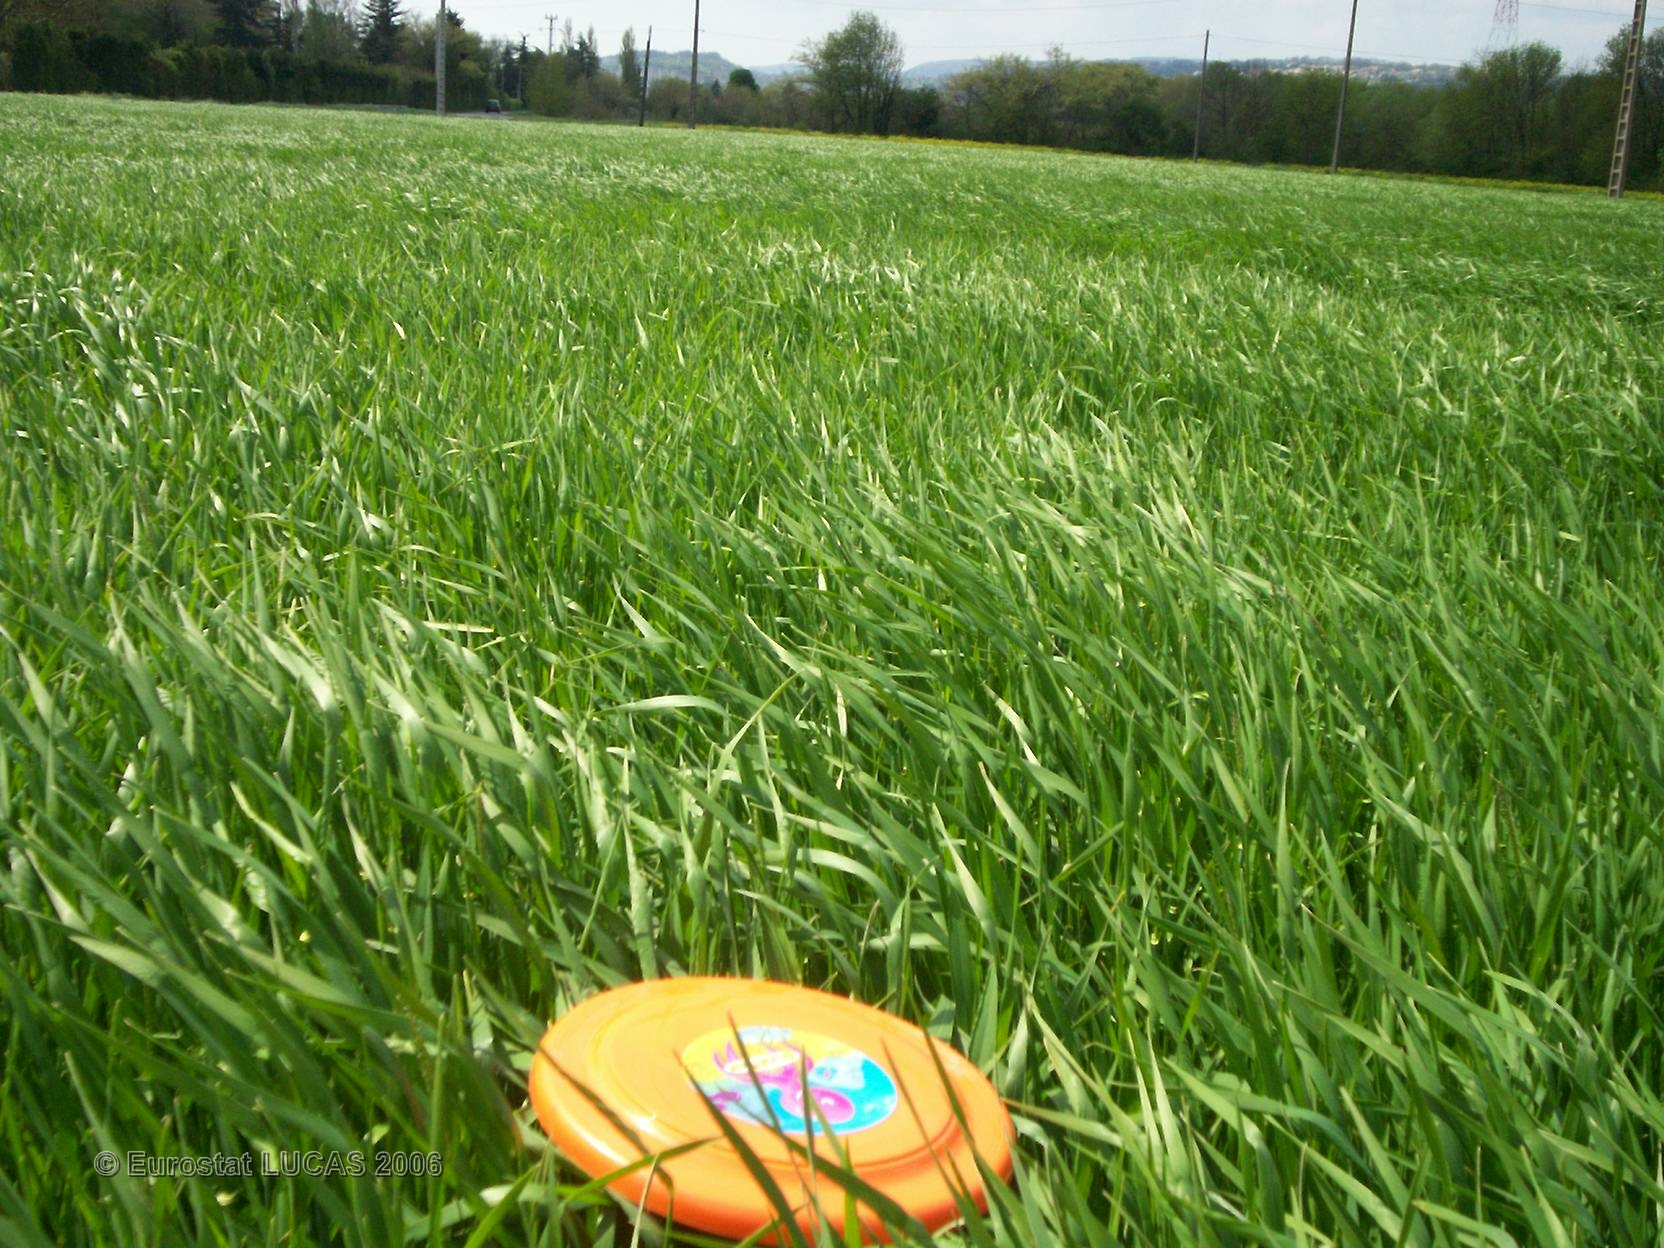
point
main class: Cropland
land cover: Barley
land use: Agriculture (excluding fallow land and kitchen gardens)
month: April
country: FR
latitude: 44.9105
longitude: 4.8760
